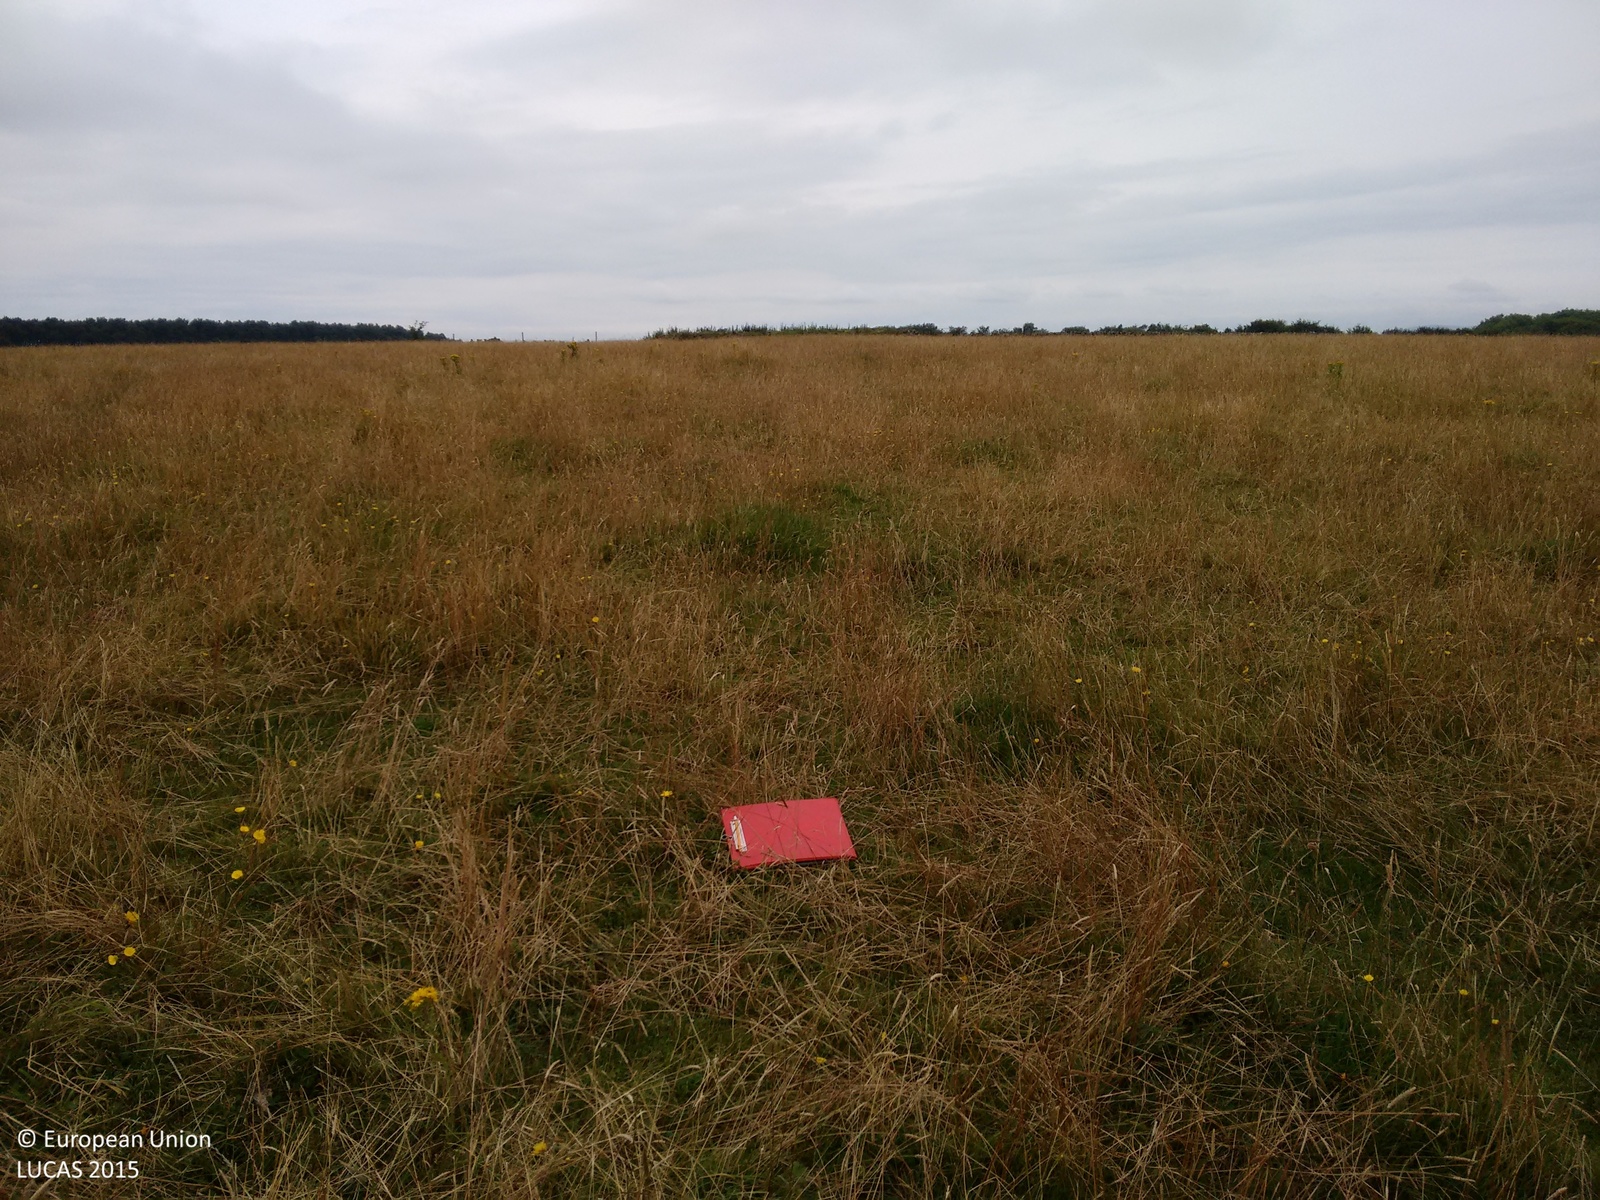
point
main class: Grassland
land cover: Grassland without tree/shrub cover
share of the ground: > 75 %
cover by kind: herbaceous plants 100 %
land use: Agriculture (excluding fallow land and kitchen gardens)
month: August
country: GB
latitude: 55.4318
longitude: -4.3355
